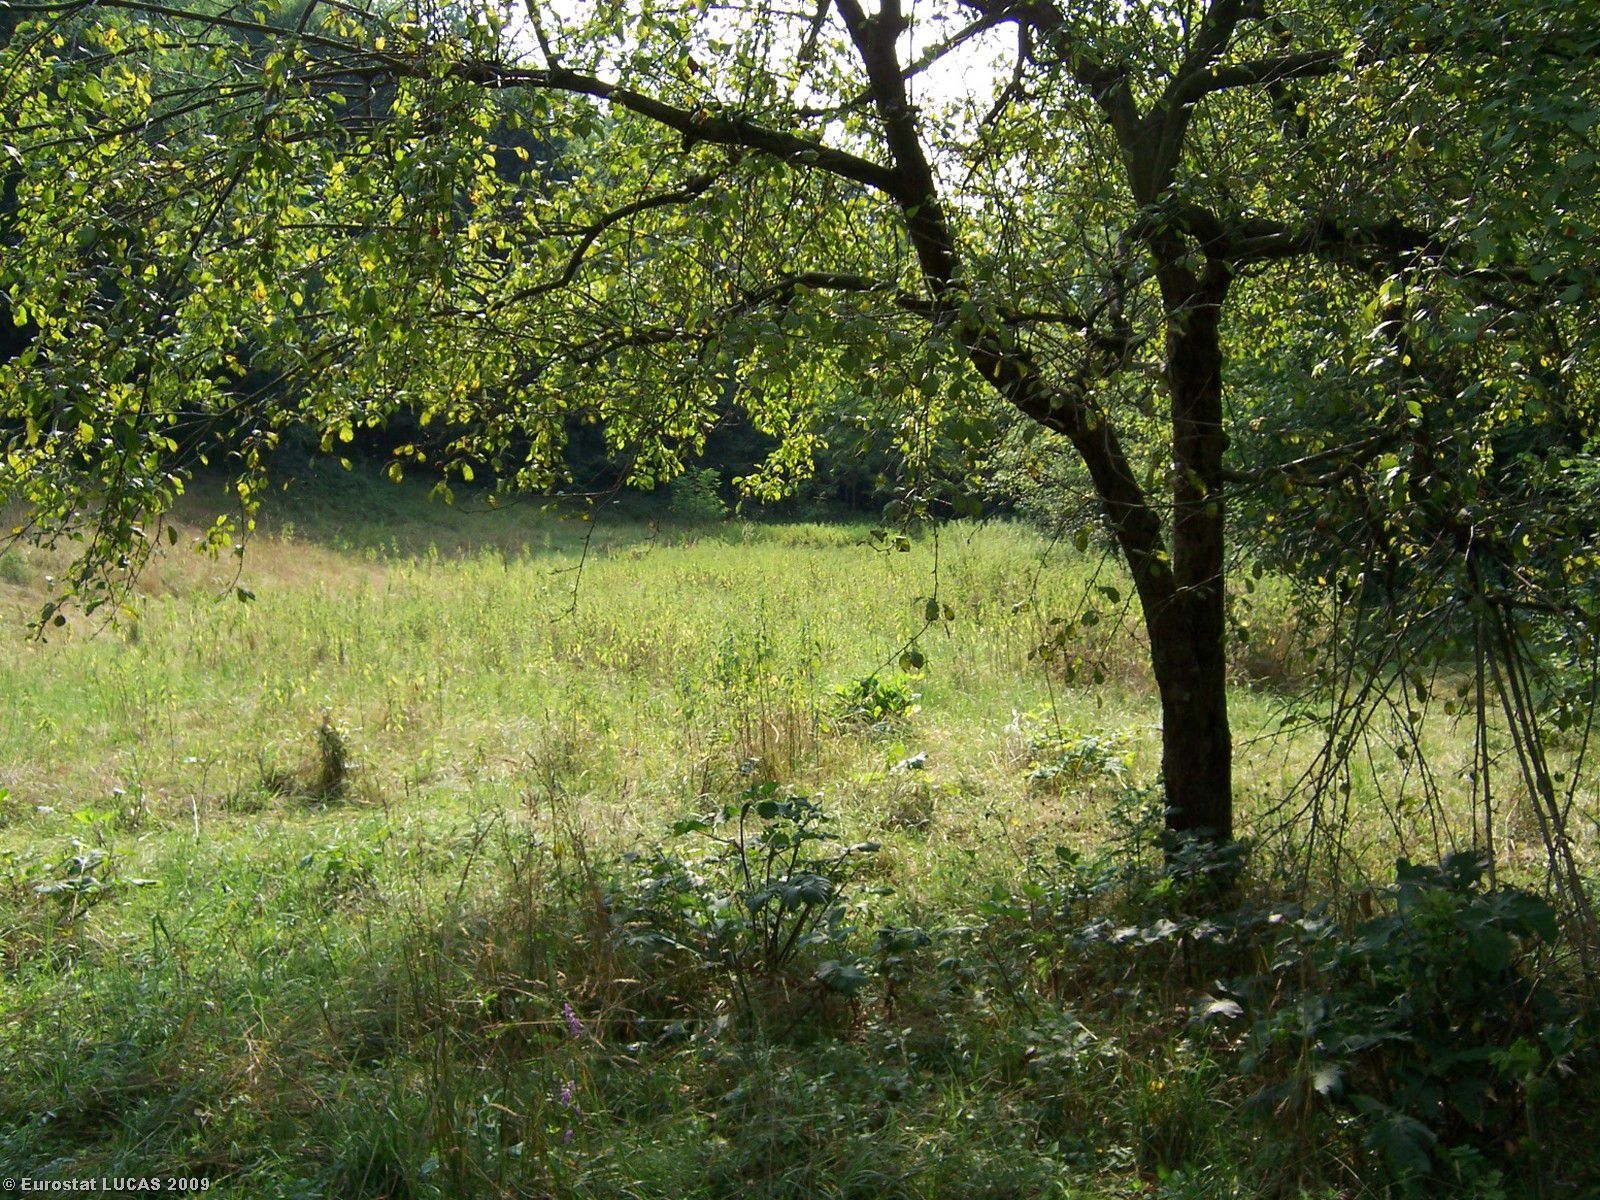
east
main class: Cropland
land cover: Apple fruit
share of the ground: > 75 %
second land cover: Grassland with sparse tree/shrub cover
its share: > 75 %
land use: Agriculture (excluding fallow land and kitchen gardens)
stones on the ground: < 10 %
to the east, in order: Apple fruit; Broadleaved woodland; Spontaneously vegetated surfaces; Broadleaved woodland
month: July
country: IT
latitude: 44.9670
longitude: 7.3801
